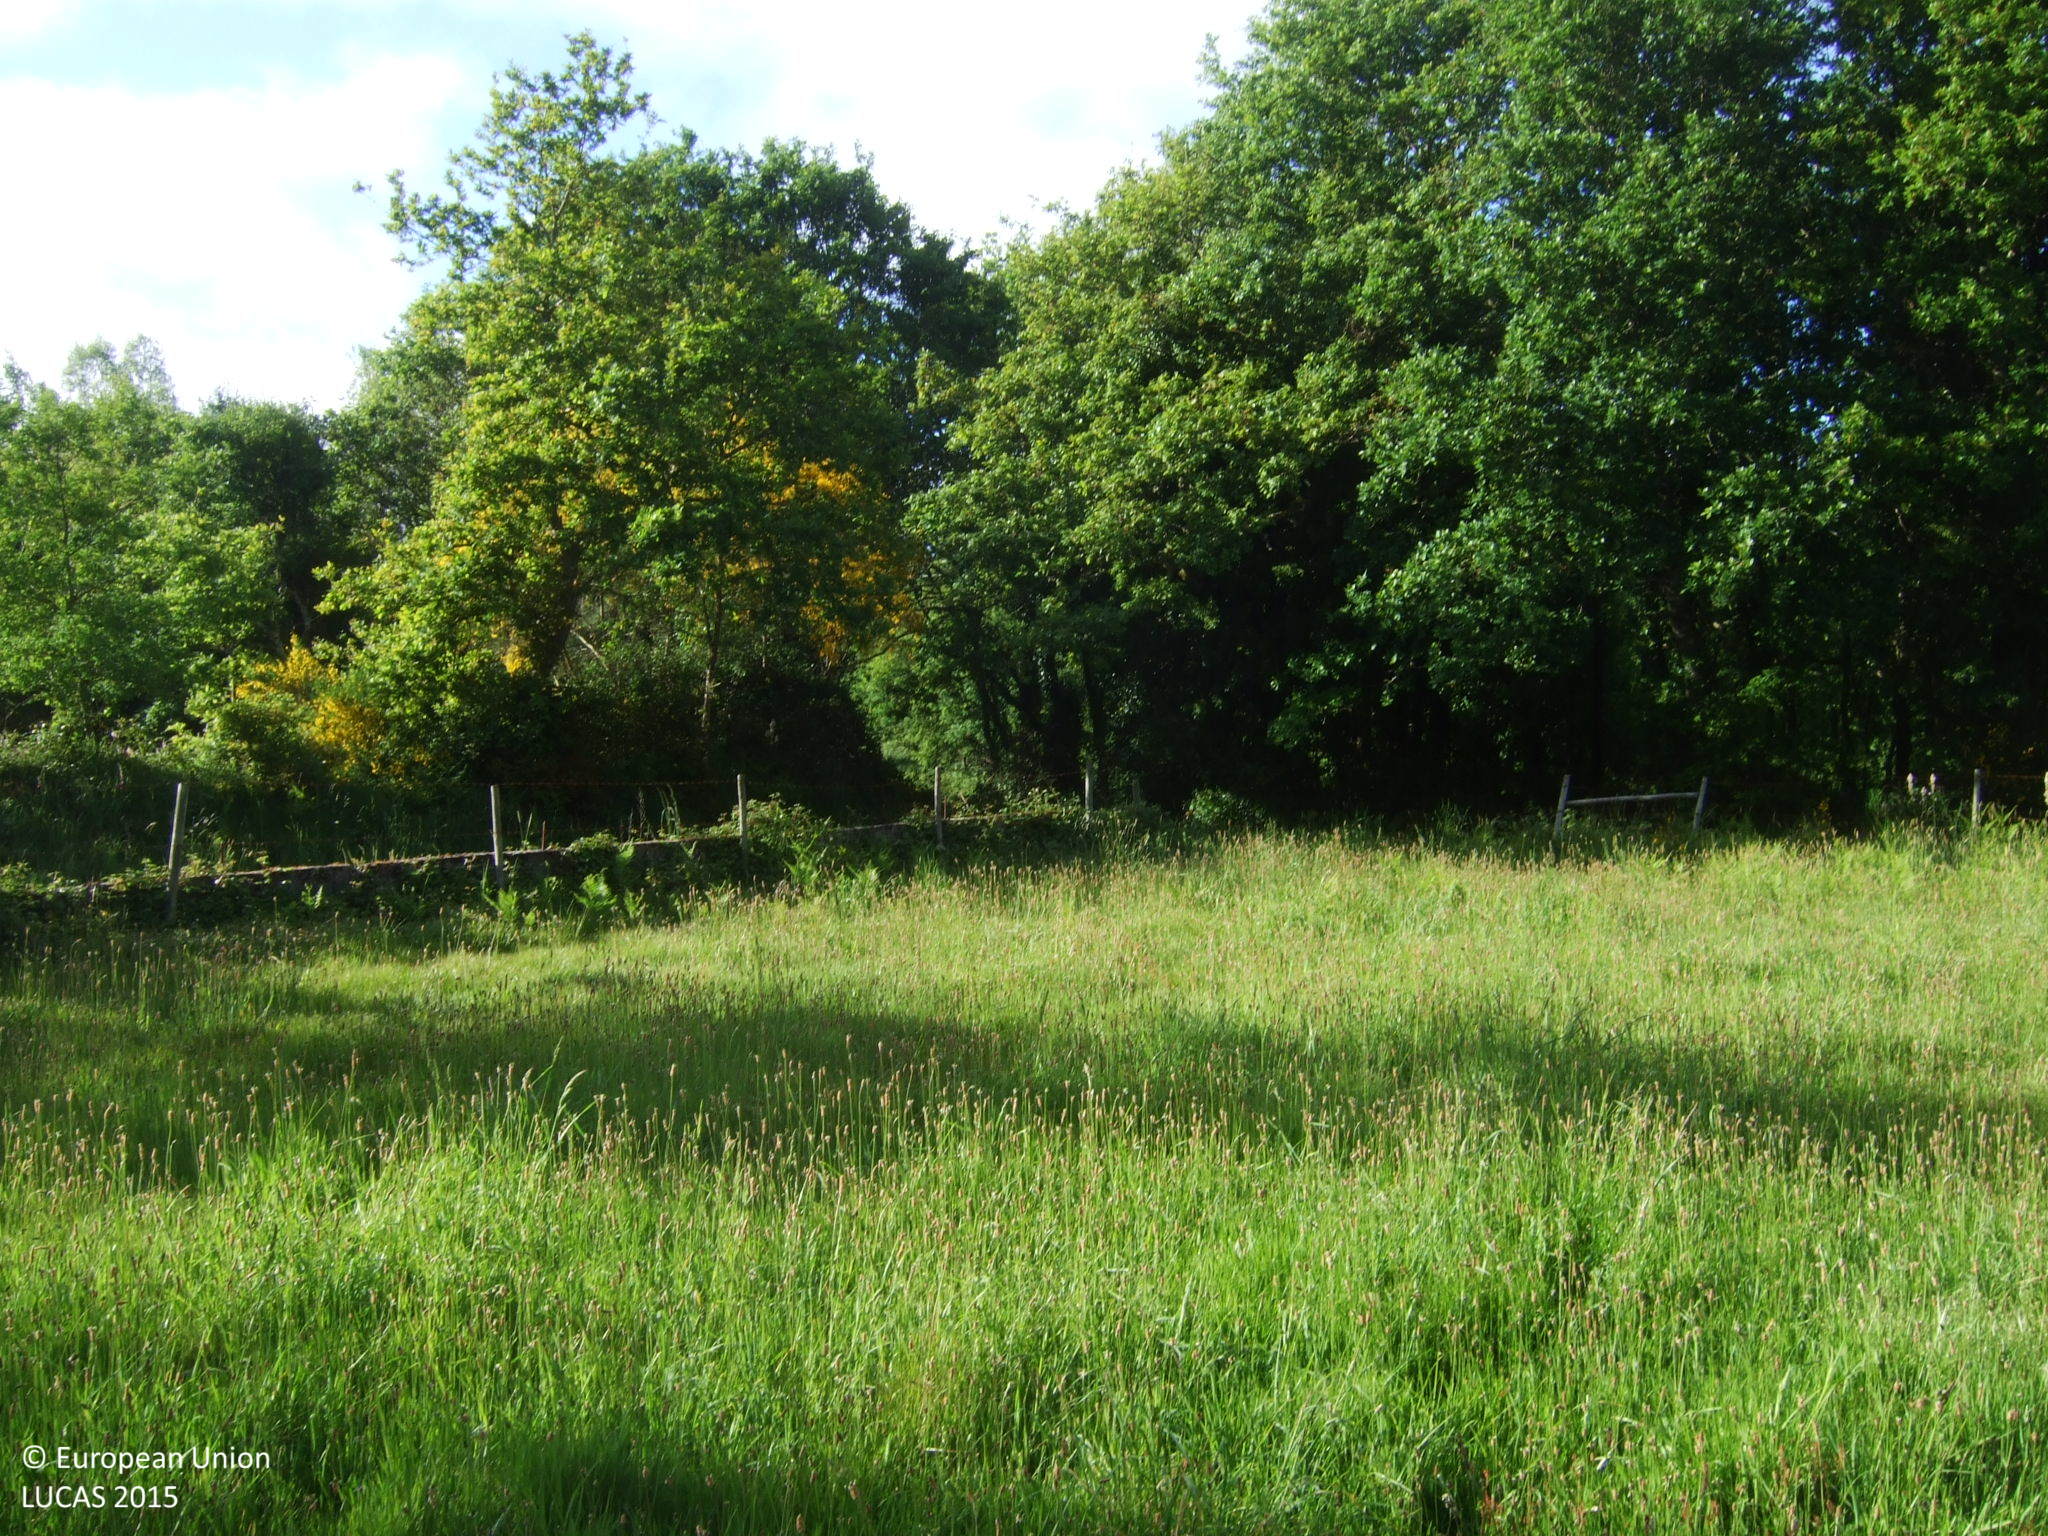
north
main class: Grassland
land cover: Grassland without tree/shrub cover
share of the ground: > 75 %
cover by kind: herbaceous plants 100 %
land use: Agriculture (excluding fallow land and kitchen gardens)
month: May
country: ES
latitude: 43.2852
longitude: -7.7461
